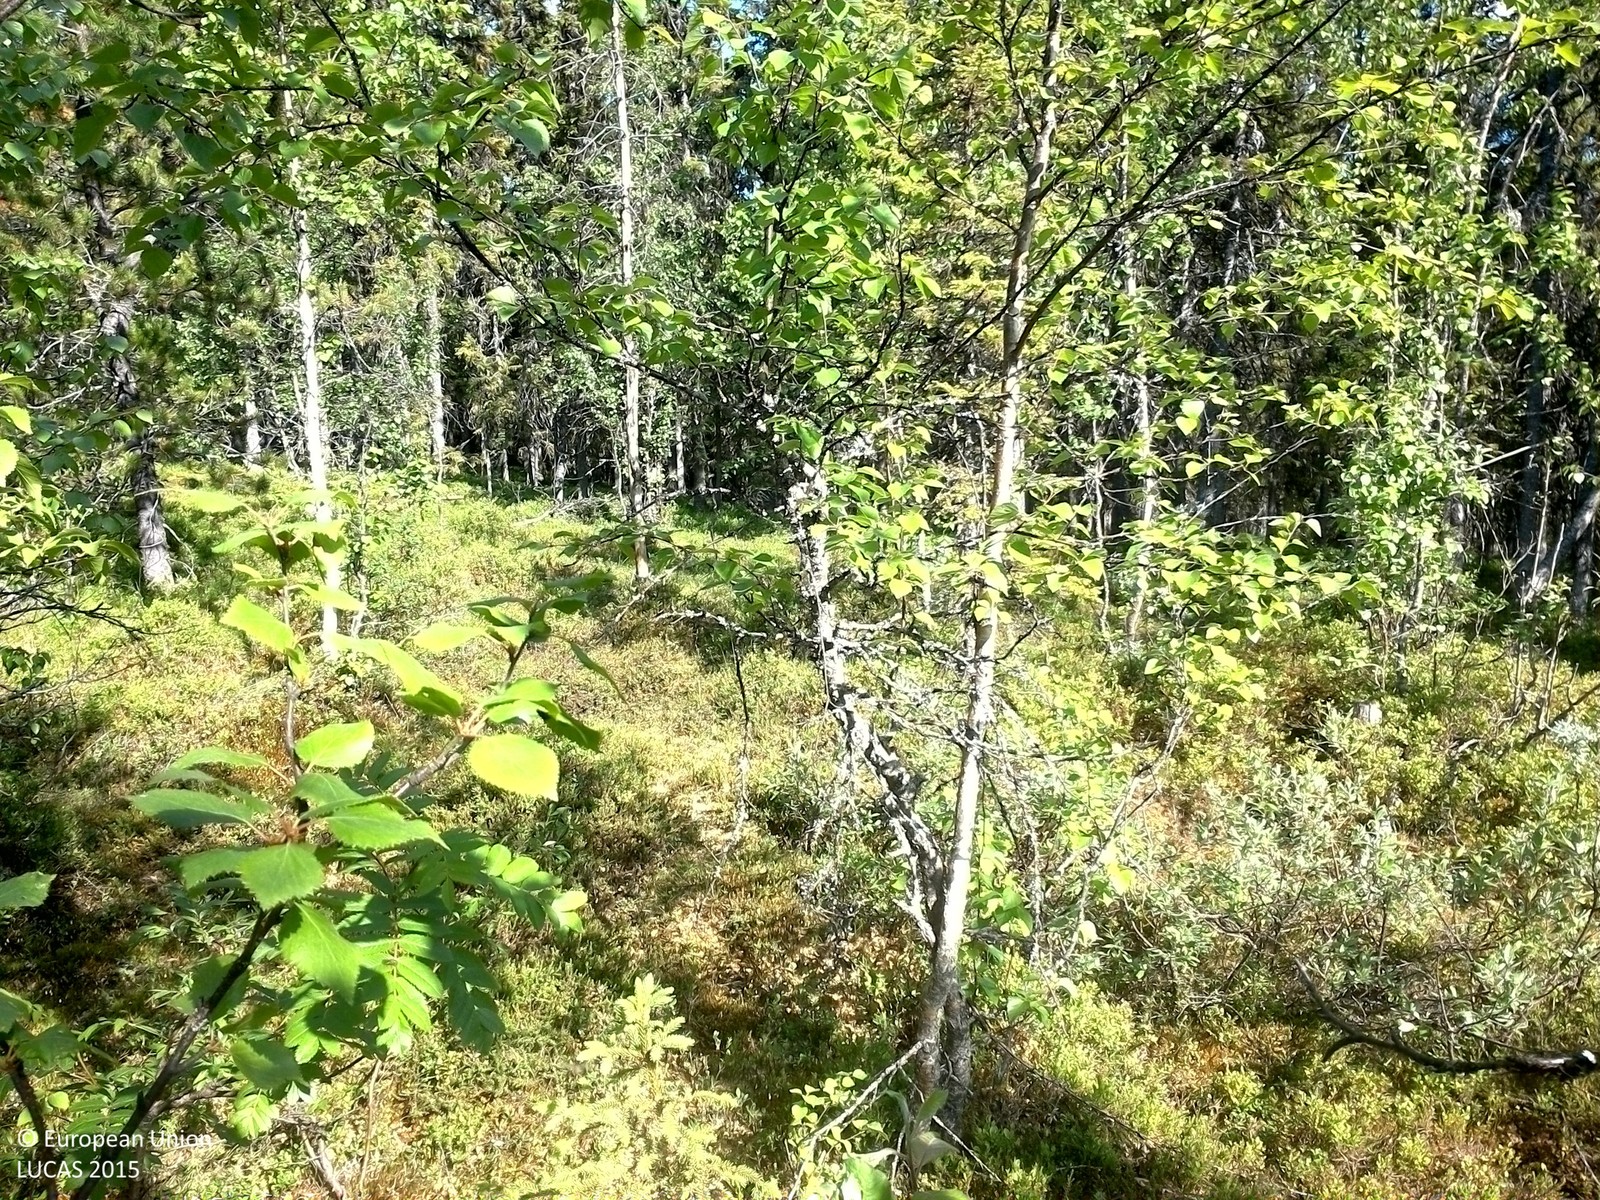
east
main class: Woodland
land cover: Spruce dominated mixed woodland
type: boreal forest
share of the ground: 50 - 75 %
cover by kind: coniferous forest trees 50 %, broadleaved forest trees 20 %, shrubs 15 %, lichens and mosses 10 %, herbaceous plants 5 %
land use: Forestry
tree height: < 5 m
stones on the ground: 10 - 25 %
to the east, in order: Spruce dominated mixed woodland; Spruce dominated coniferous woodland; Shrubland with sparse tree cover; Spruce dominated mixed woodland; Ditches and canals; Spruce dominated mixed woodland
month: July
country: SE
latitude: 64.3868
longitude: 16.6236
